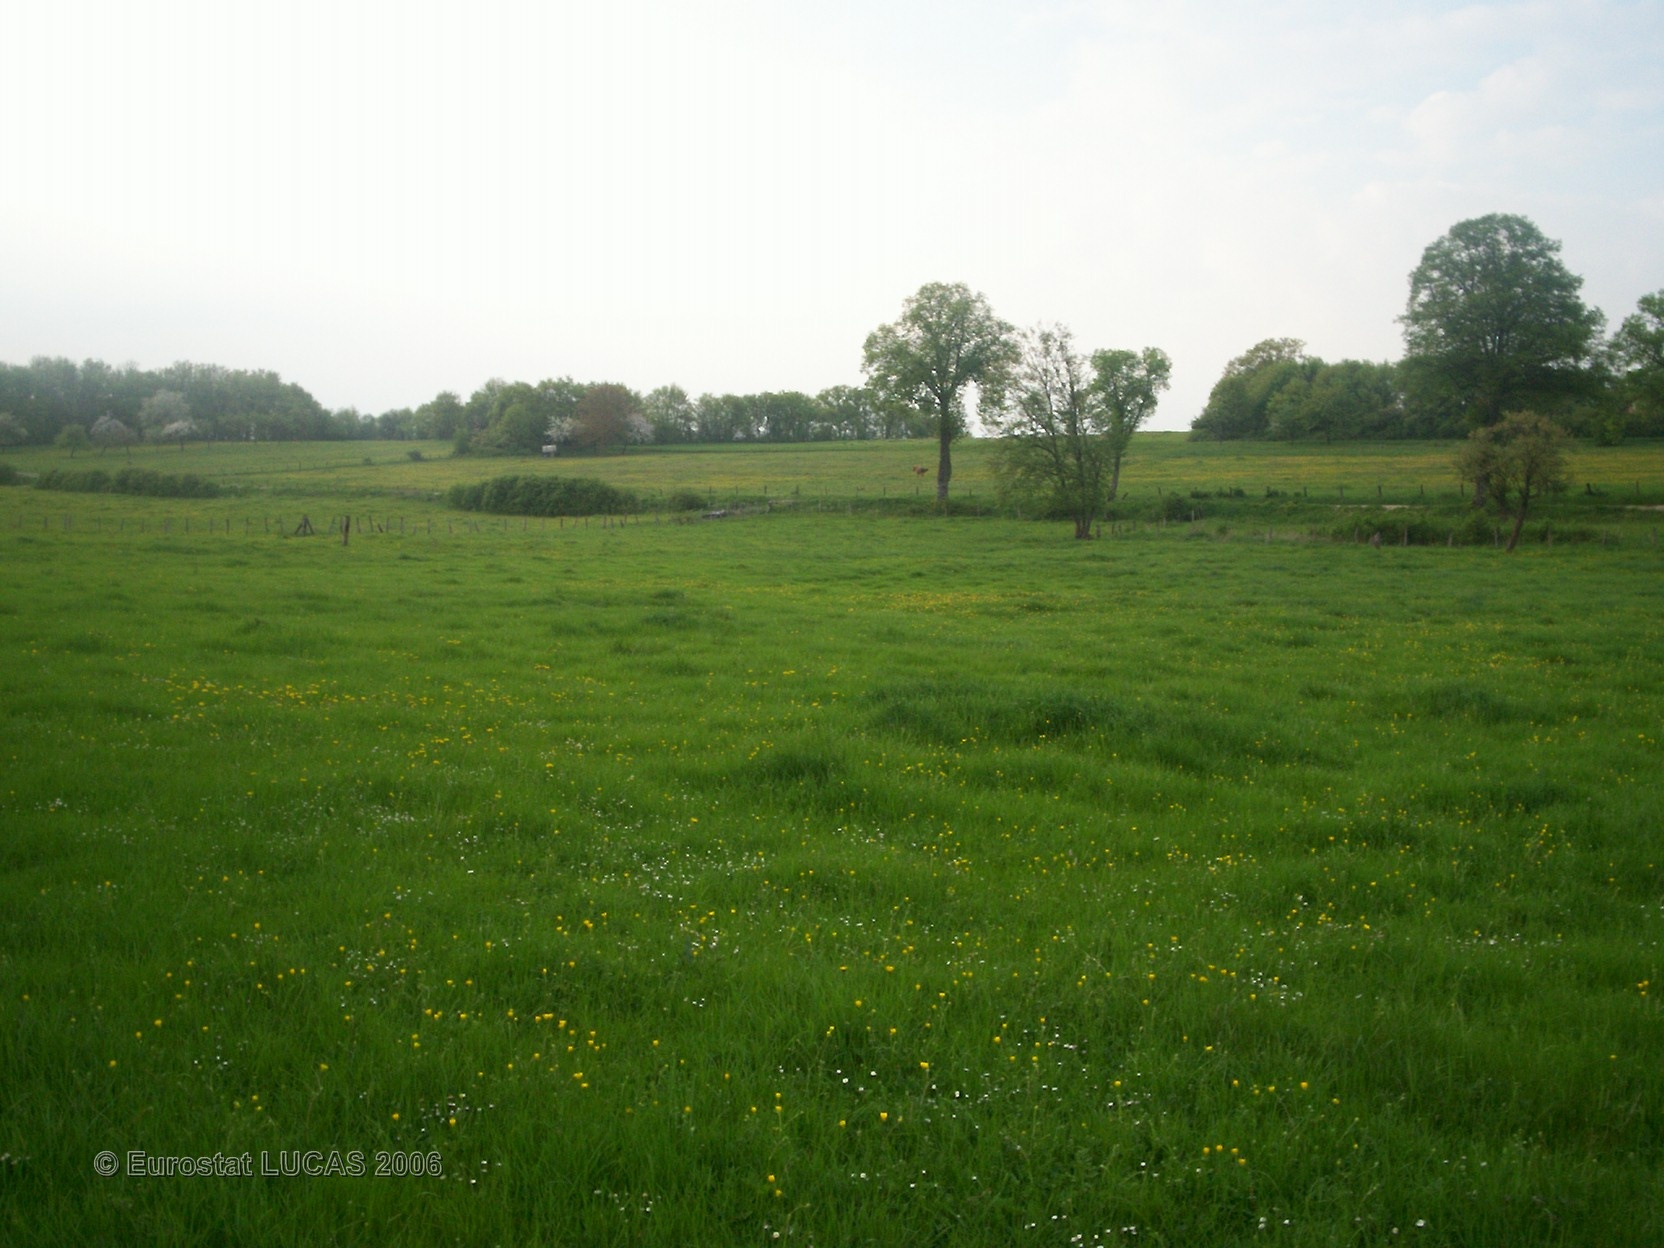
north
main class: Grassland
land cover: Grassland without tree/shrub cover
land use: Agriculture (excluding fallow land and kitchen gardens)
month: May
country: FR
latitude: 48.7588
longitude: 6.9943
